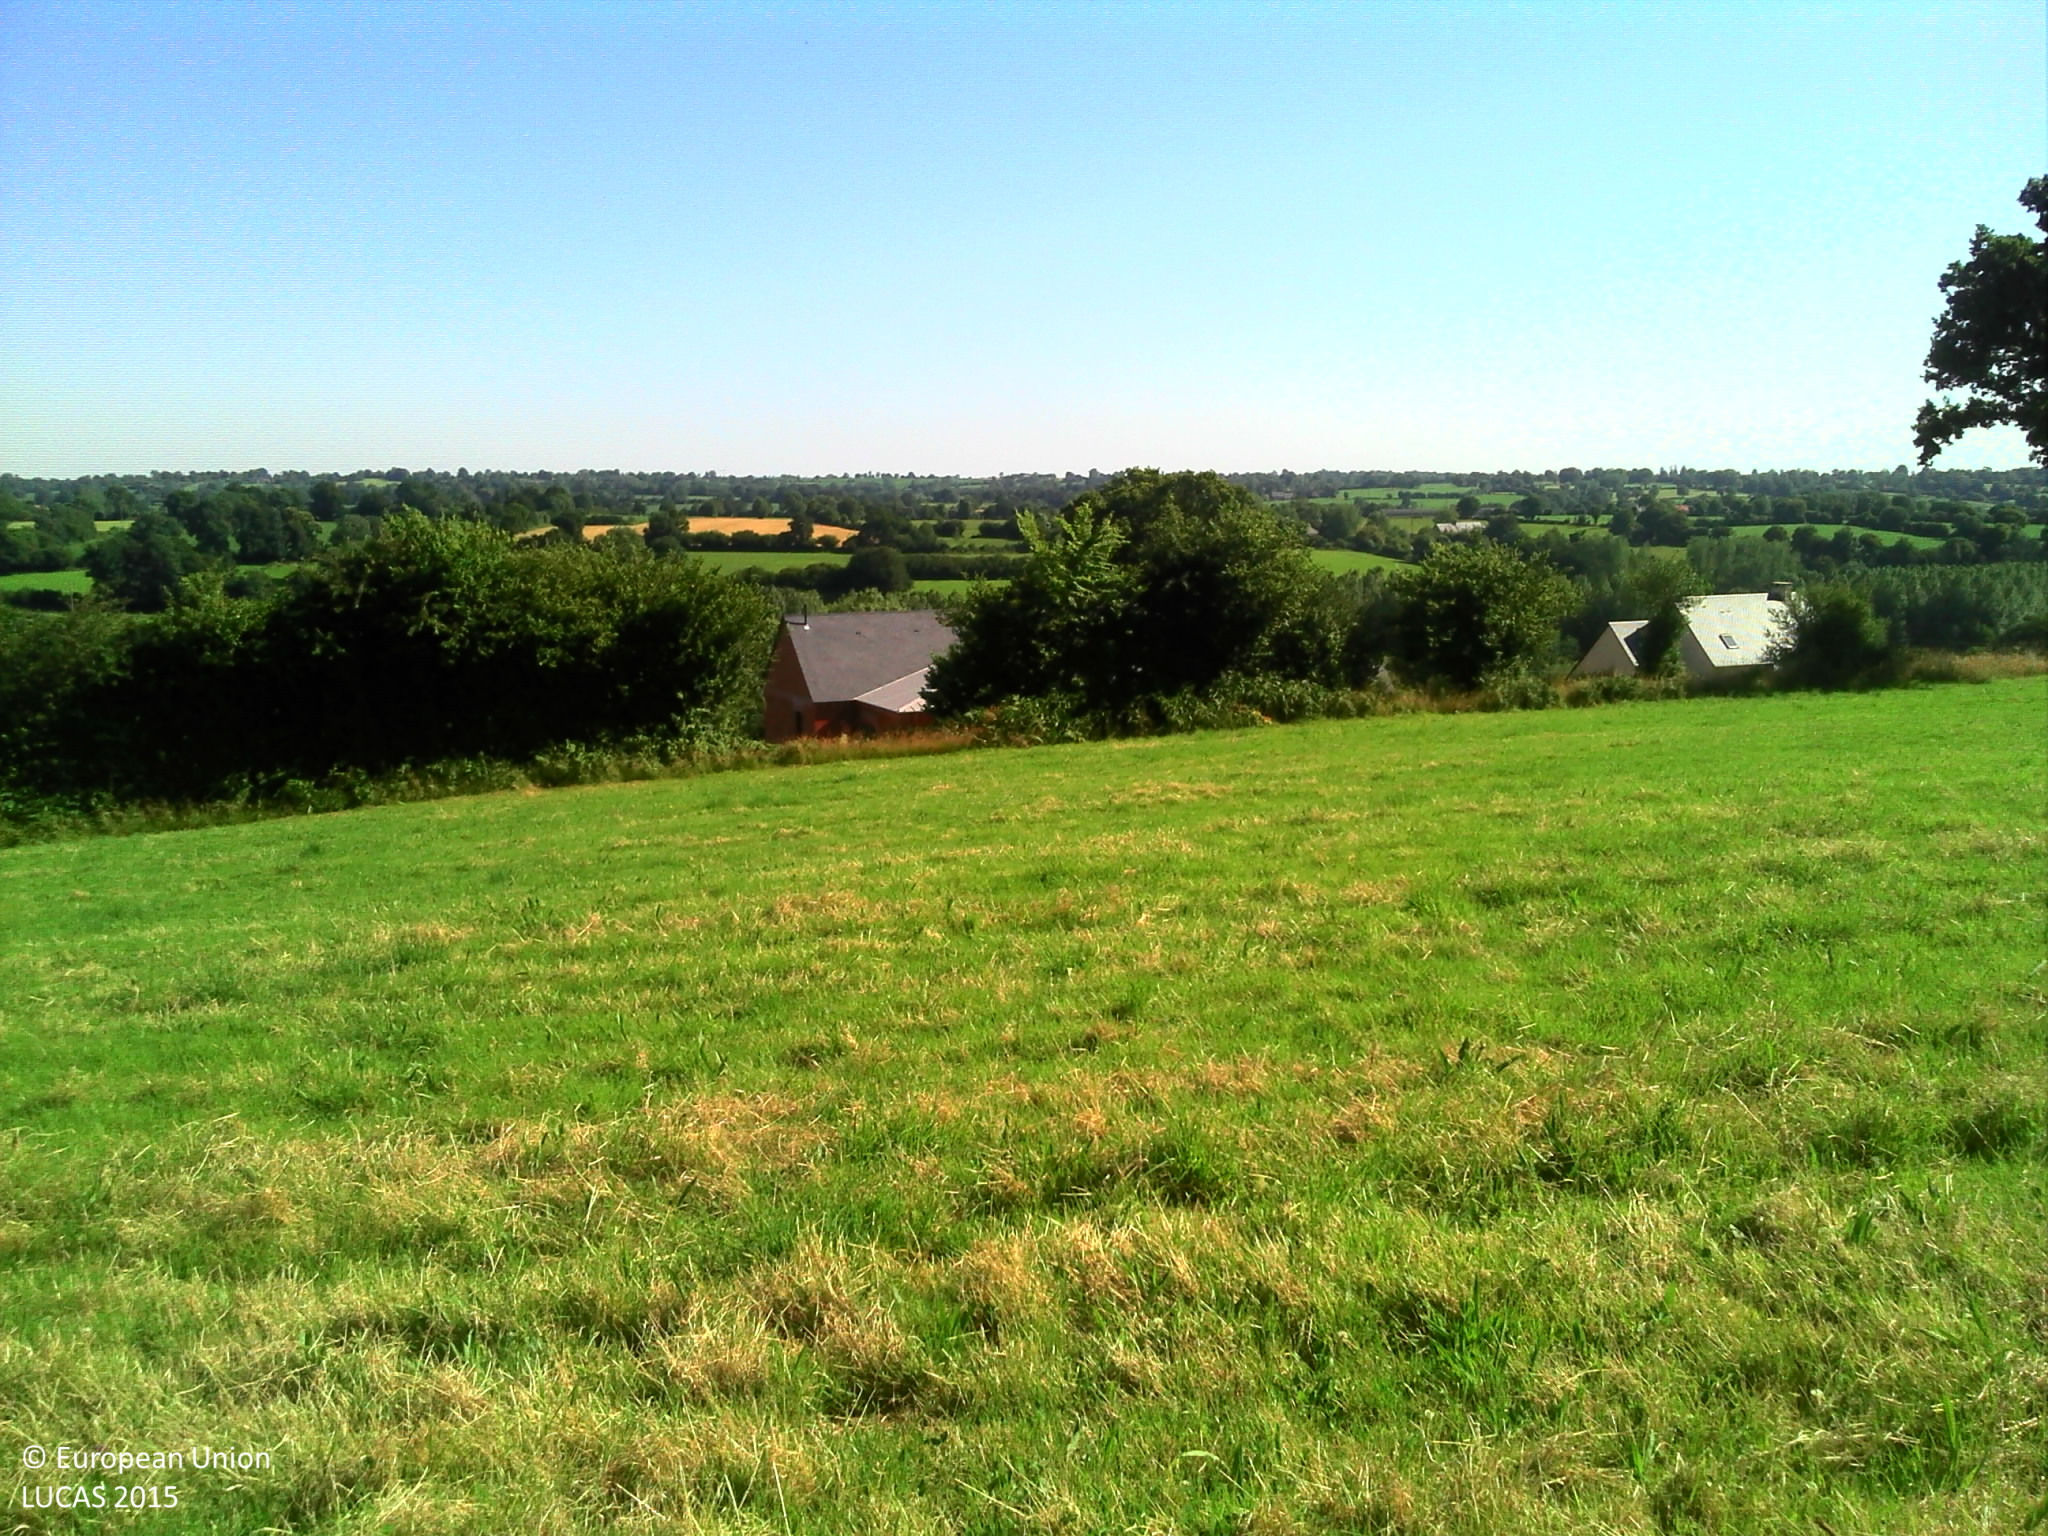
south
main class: Grassland
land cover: Grassland without tree/shrub cover
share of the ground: > 75 %
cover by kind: herbaceous plants 100 %
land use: Agriculture (excluding fallow land and kitchen gardens)
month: July
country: FR
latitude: 49.0211
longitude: -1.3000
